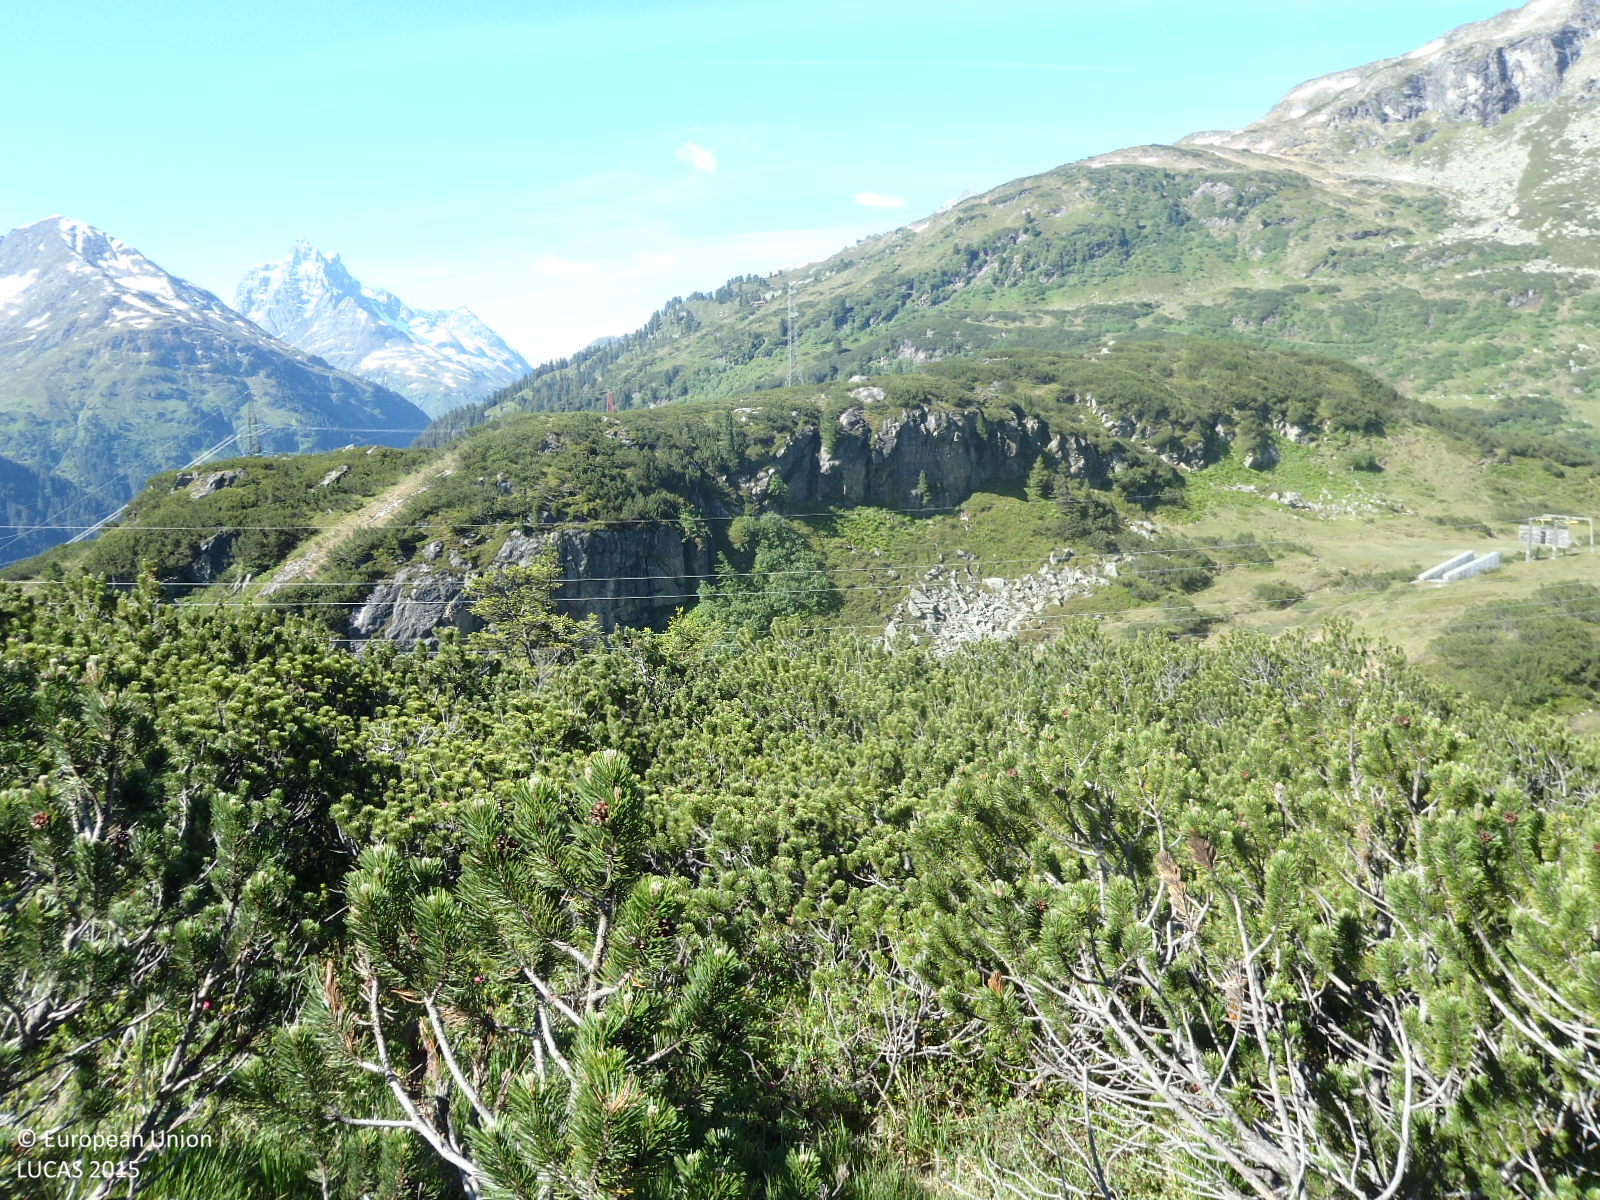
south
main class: Shrubland
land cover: Shrubland without tree cover
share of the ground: > 75 %
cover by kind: shrubs 95 %, herbaceous plants 5 %
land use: Sport
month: June
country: AT
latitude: 47.1253
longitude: 10.2239
